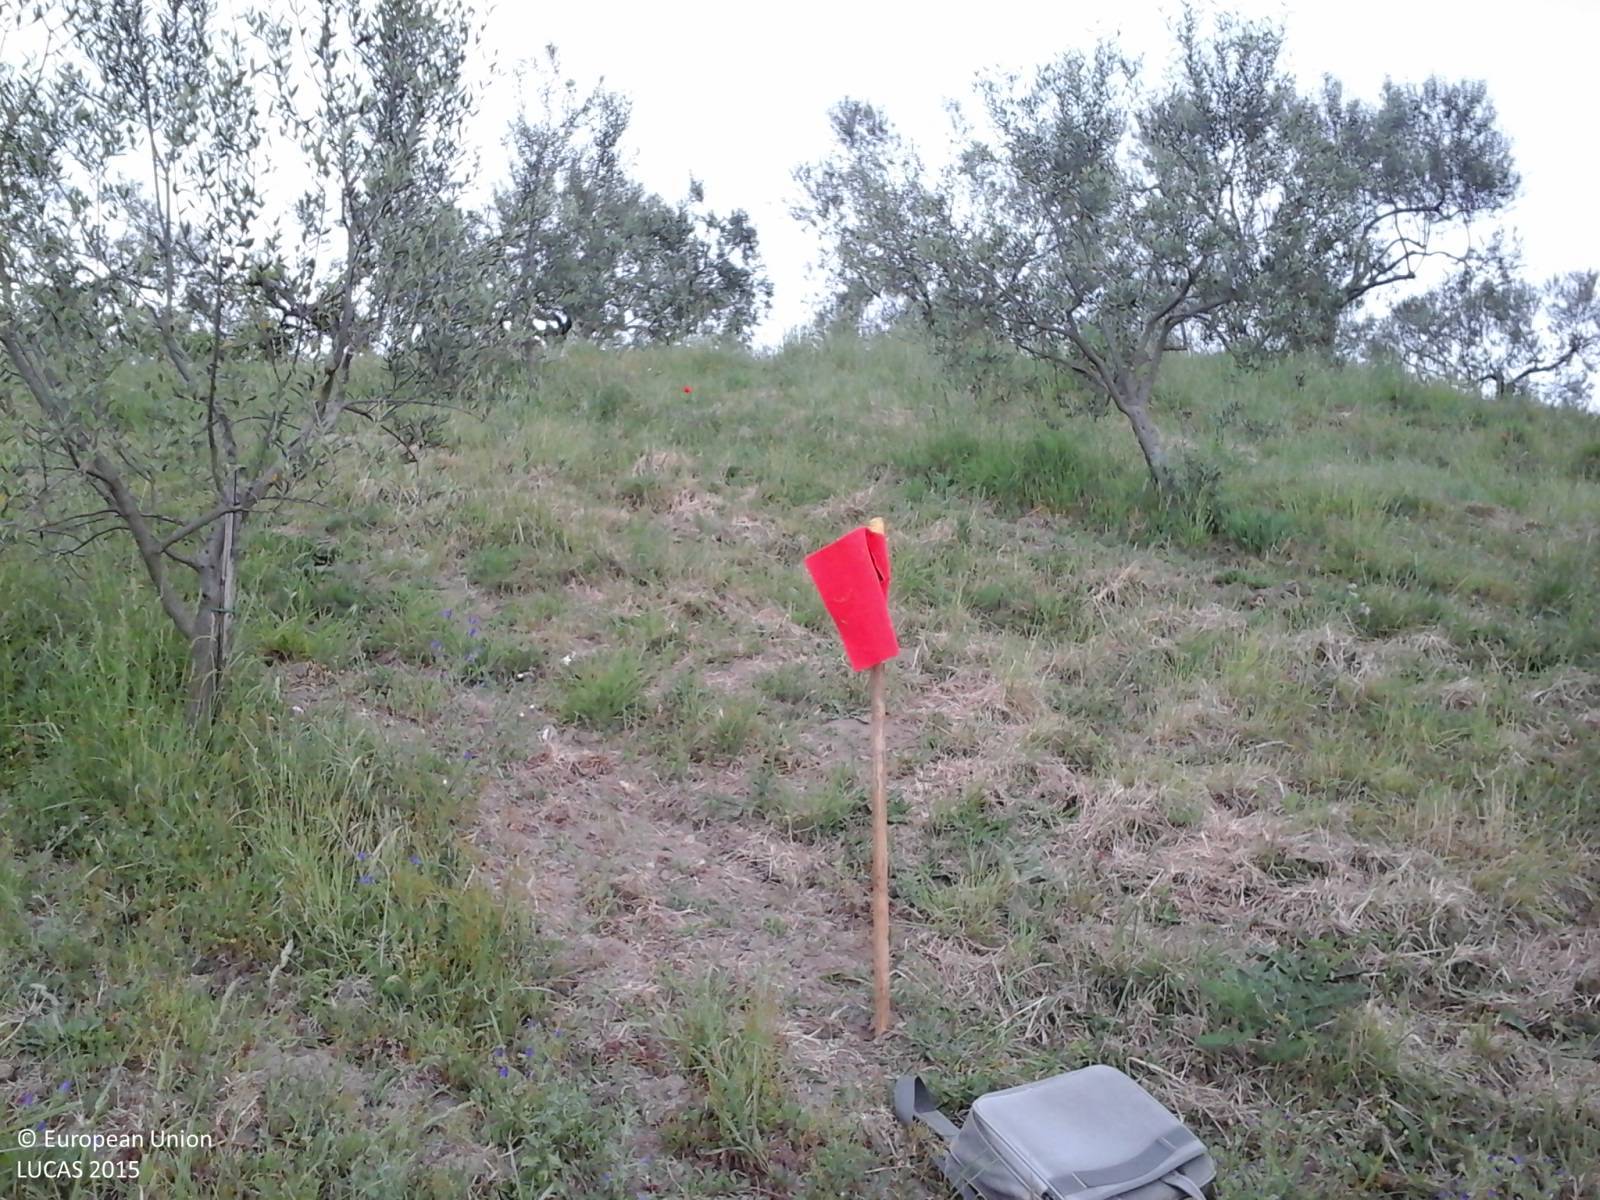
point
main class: Cropland
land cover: Olive groves
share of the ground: 25 - 50 %
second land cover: Grassland without tree/shrub cover
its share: > 75 %
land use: Agriculture (excluding fallow land and kitchen gardens)
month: May
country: IT
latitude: 42.5610
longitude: 12.0517
